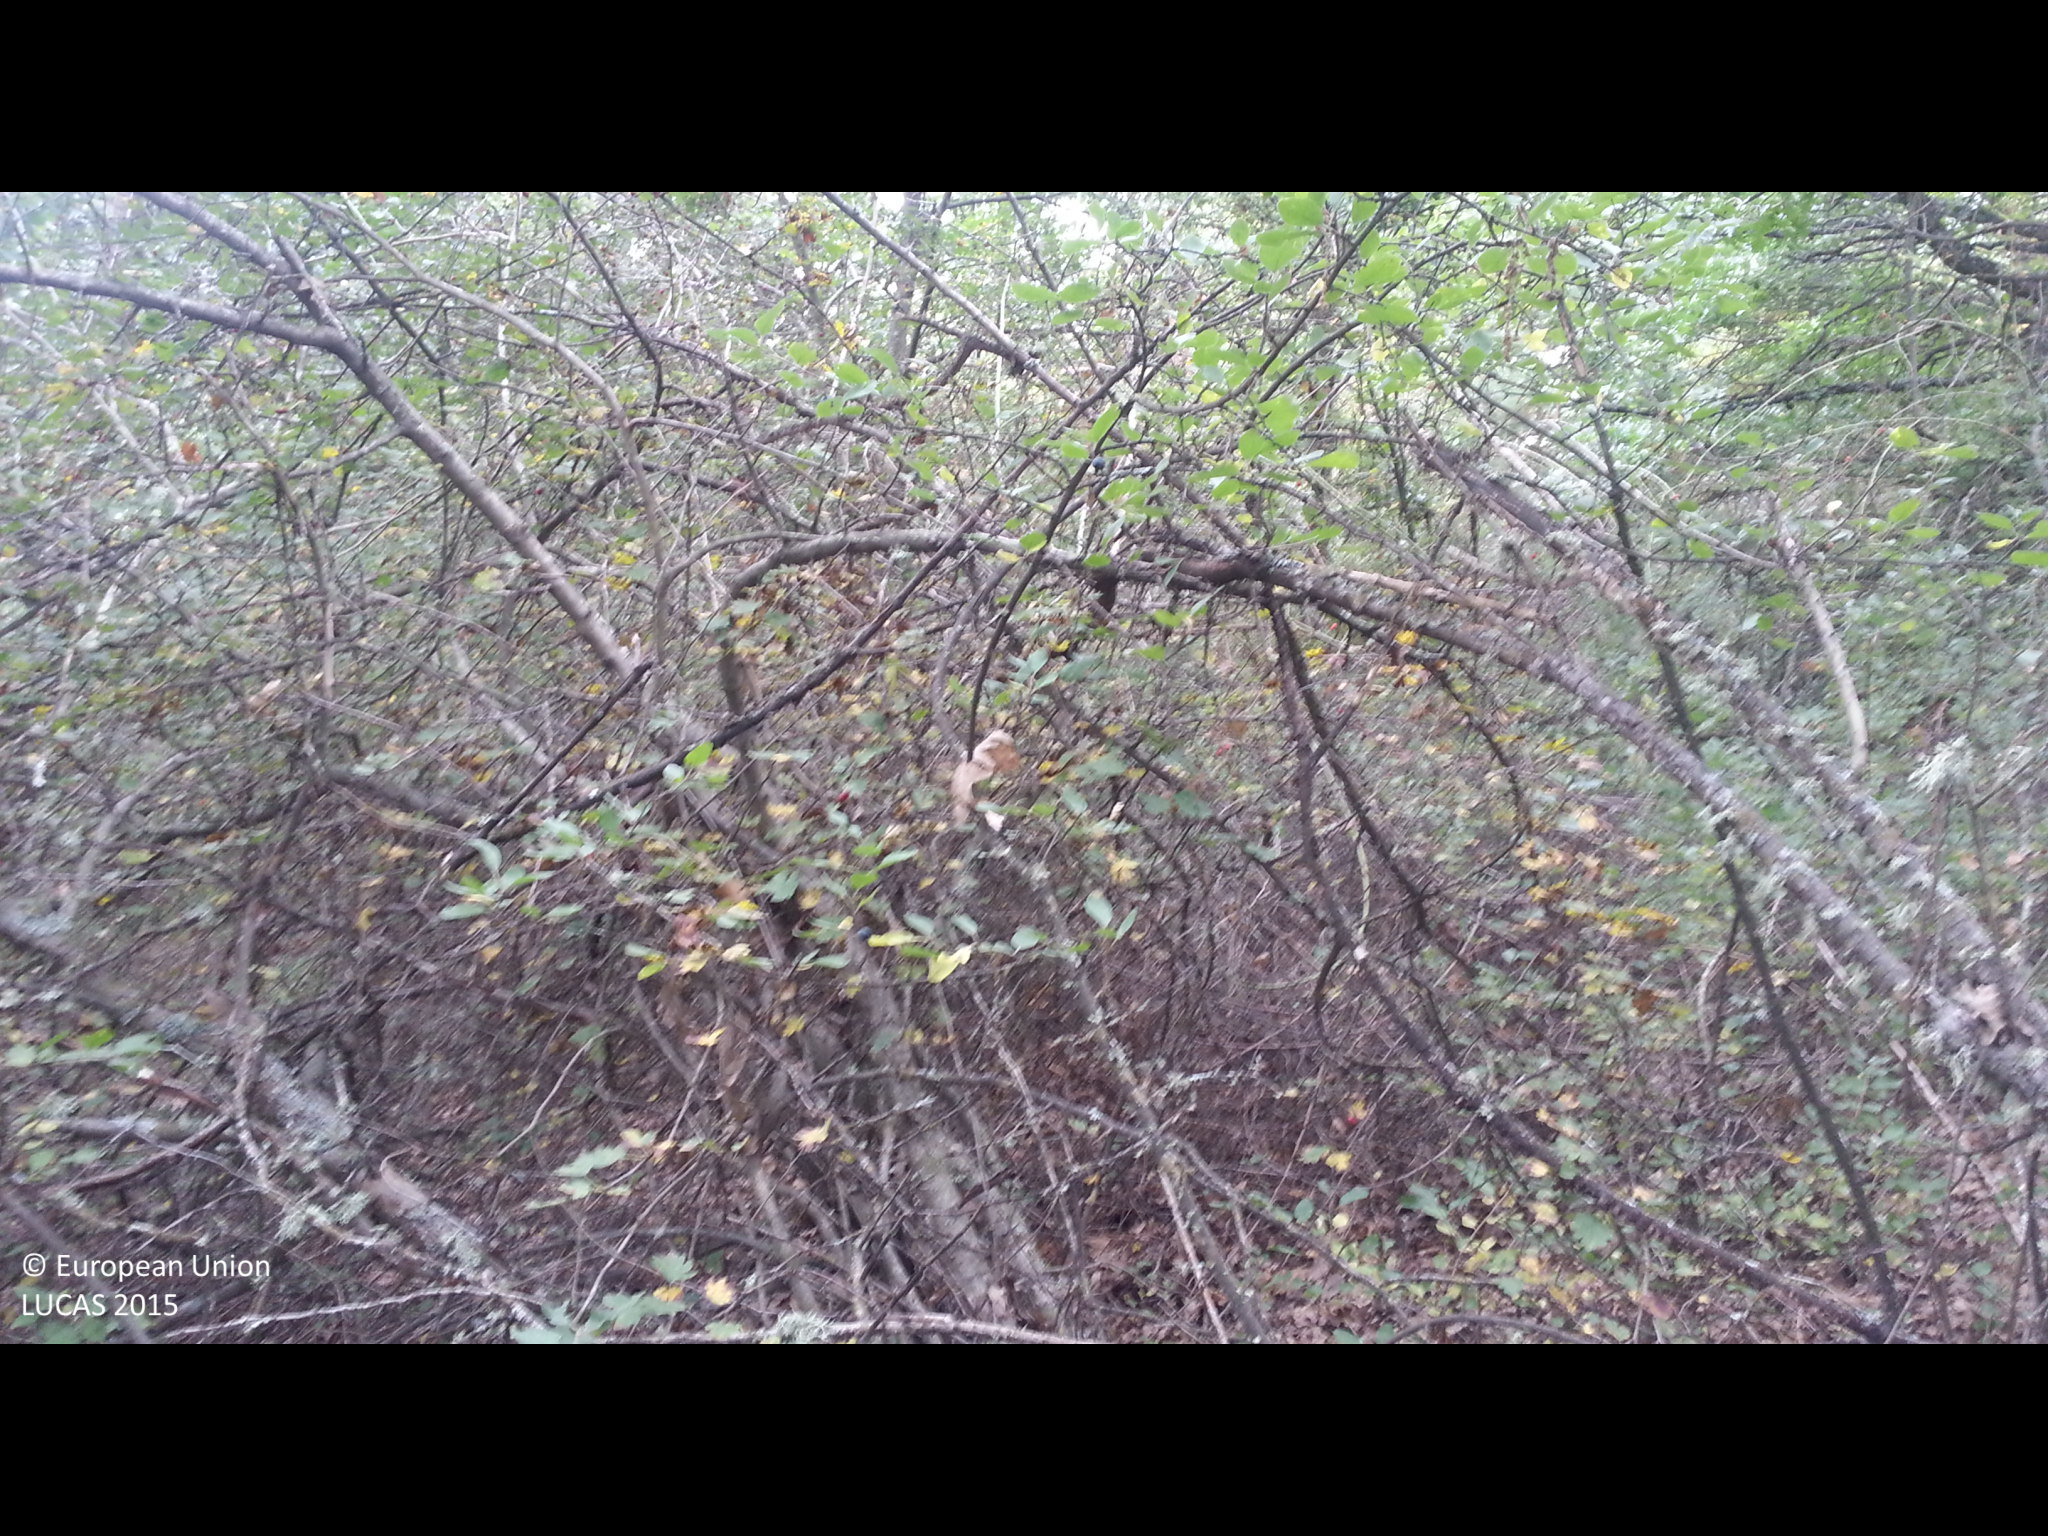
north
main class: Woodland
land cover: Broadleaved woodland
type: mesophytic deciduous forest
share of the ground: > 75 %
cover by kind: broadleaved forest trees 85 %, shrubs 10 %, coniferous forest trees 5 %
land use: Forestry
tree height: > 5 m
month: September
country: BG
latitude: 42.3760
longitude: 22.5910
